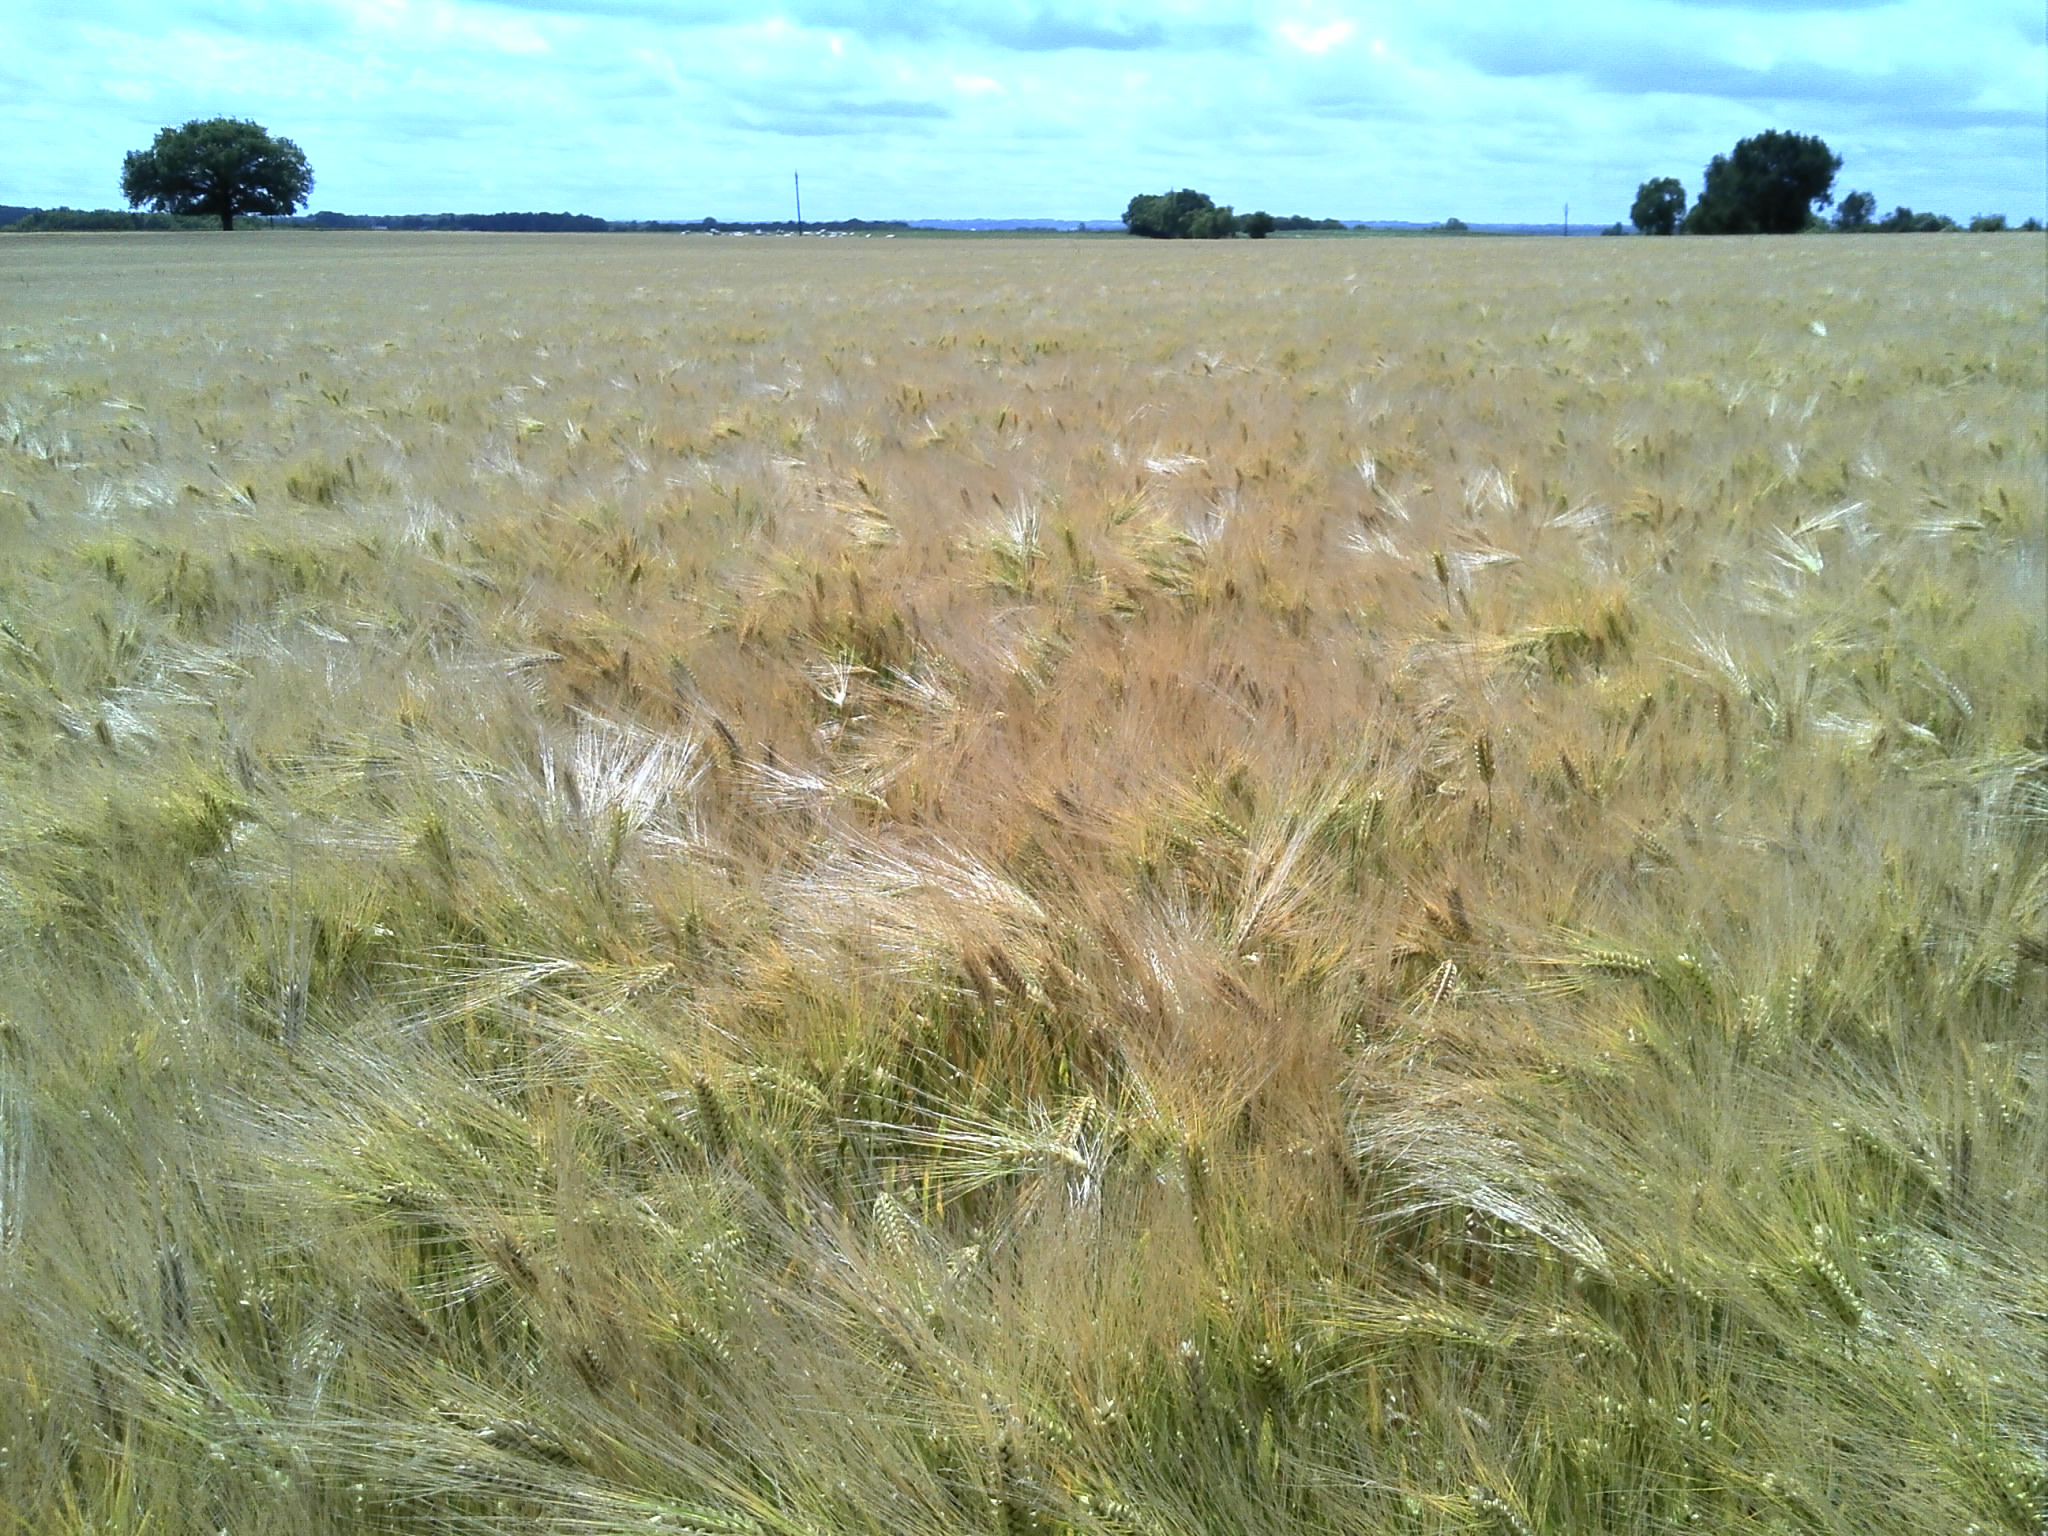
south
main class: Cropland
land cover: Barley
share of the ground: > 75 %
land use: Agriculture (excluding fallow land and kitchen gardens)
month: June
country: FR
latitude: 46.6627
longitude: 1.4809
